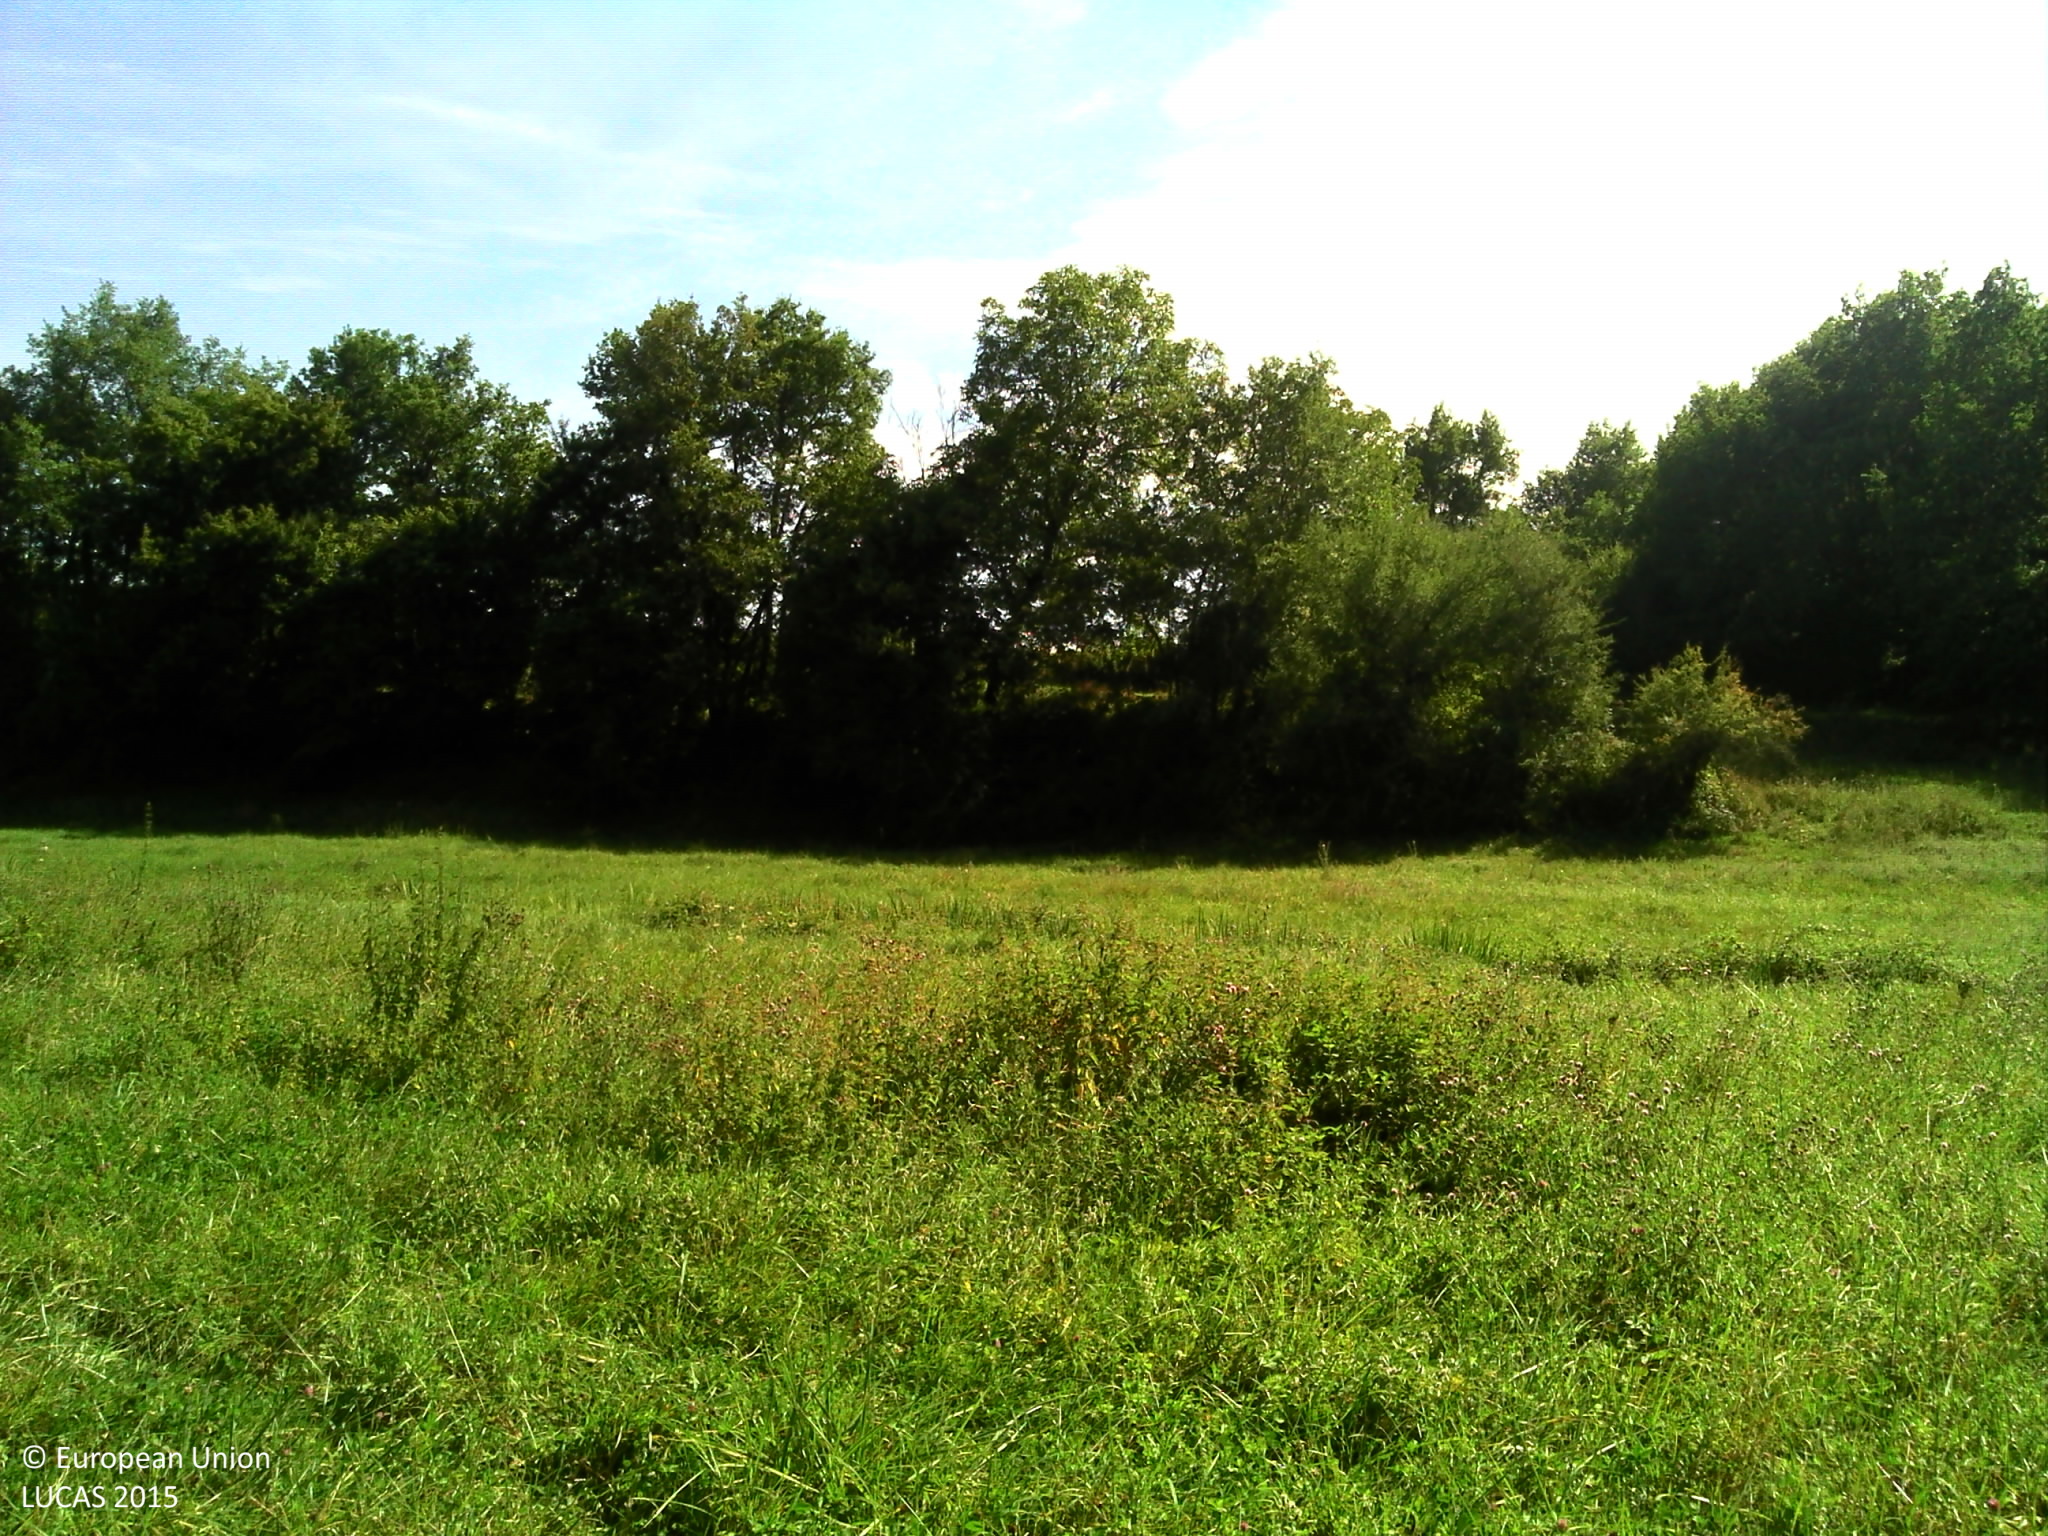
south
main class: Woodland
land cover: Broadleaved woodland
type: acidophilous oak and oak-birch forest
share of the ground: > 75 %
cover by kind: broadleaved forest trees 40 %, shrubs 30 %, herbaceous plants 20 %, unconsolidated bare surface 10 %
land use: Forestry
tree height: > 5 m
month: August
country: FR
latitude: 45.3943
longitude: 0.4194
